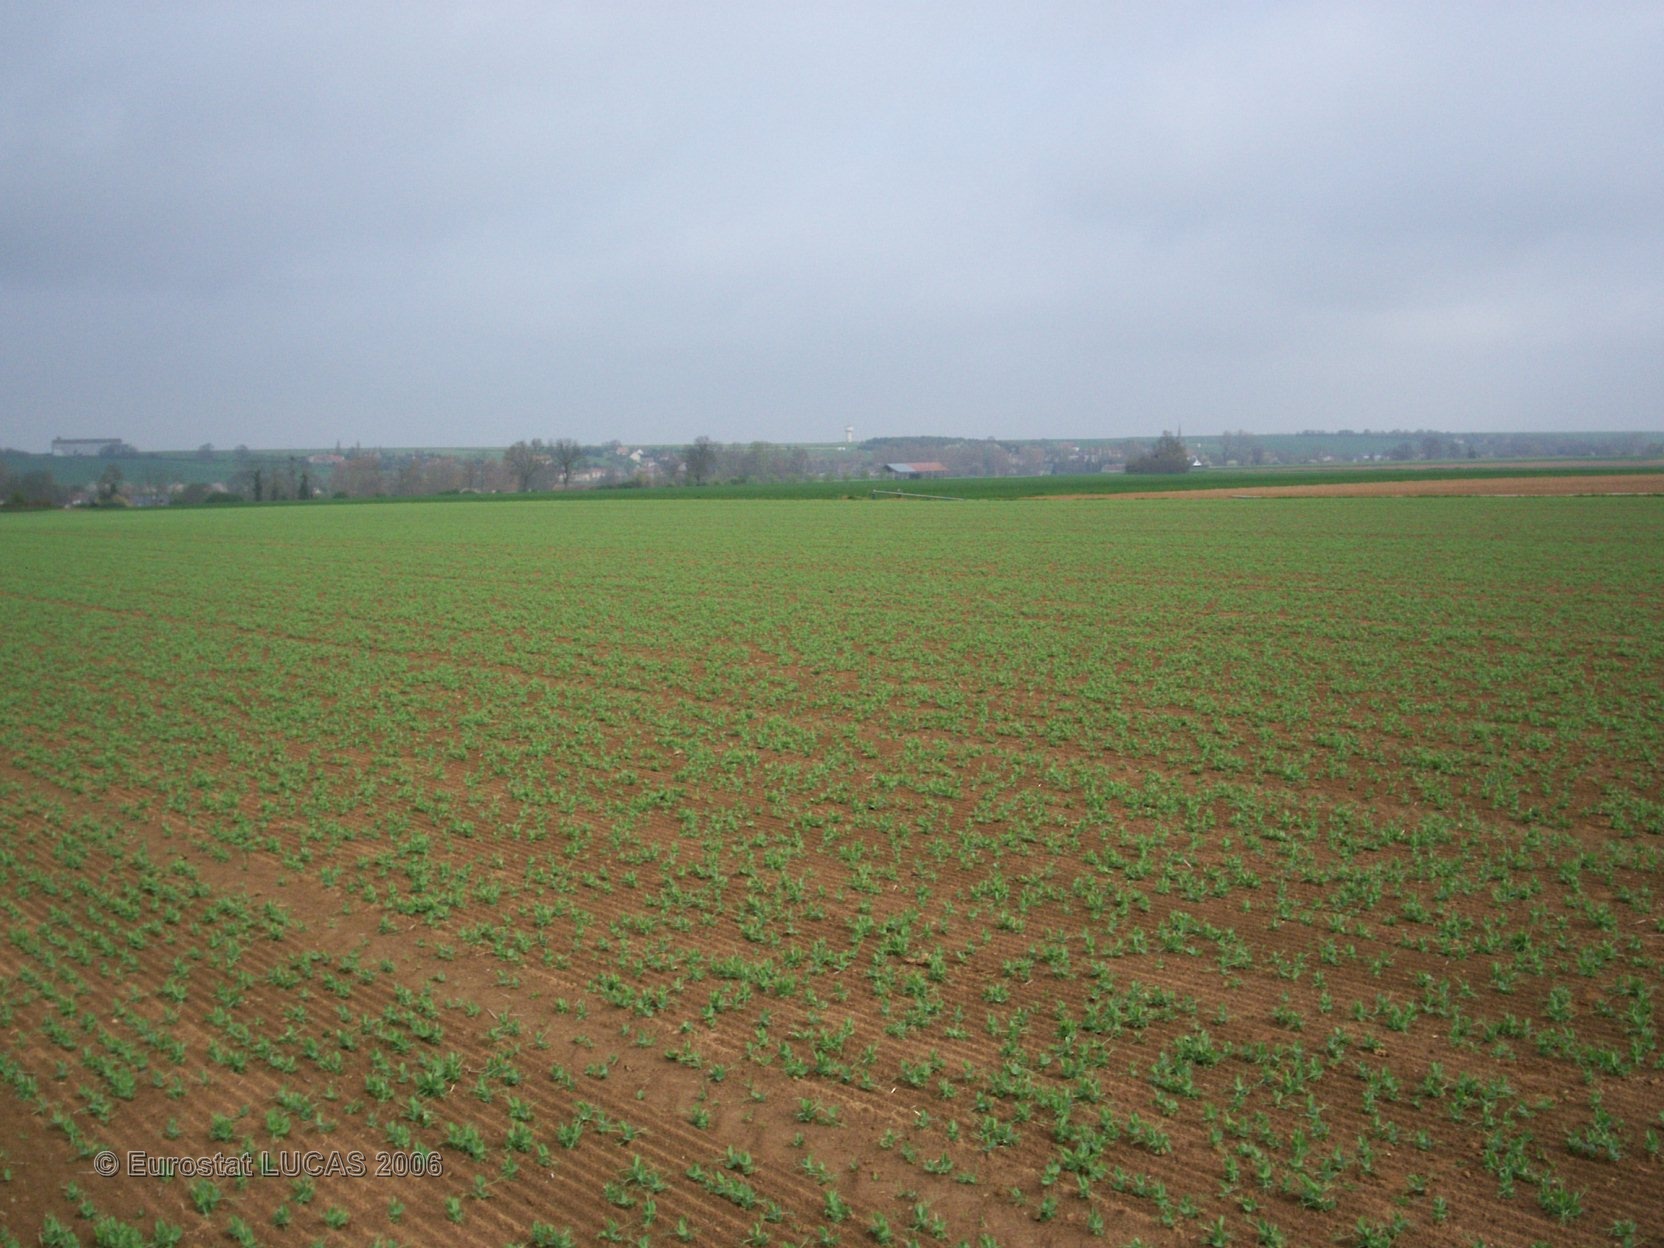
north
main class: Cropland
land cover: Dry pulses
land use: Agriculture (excluding fallow land and kitchen gardens)
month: April
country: FR
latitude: 49.0039
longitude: -0.1618
